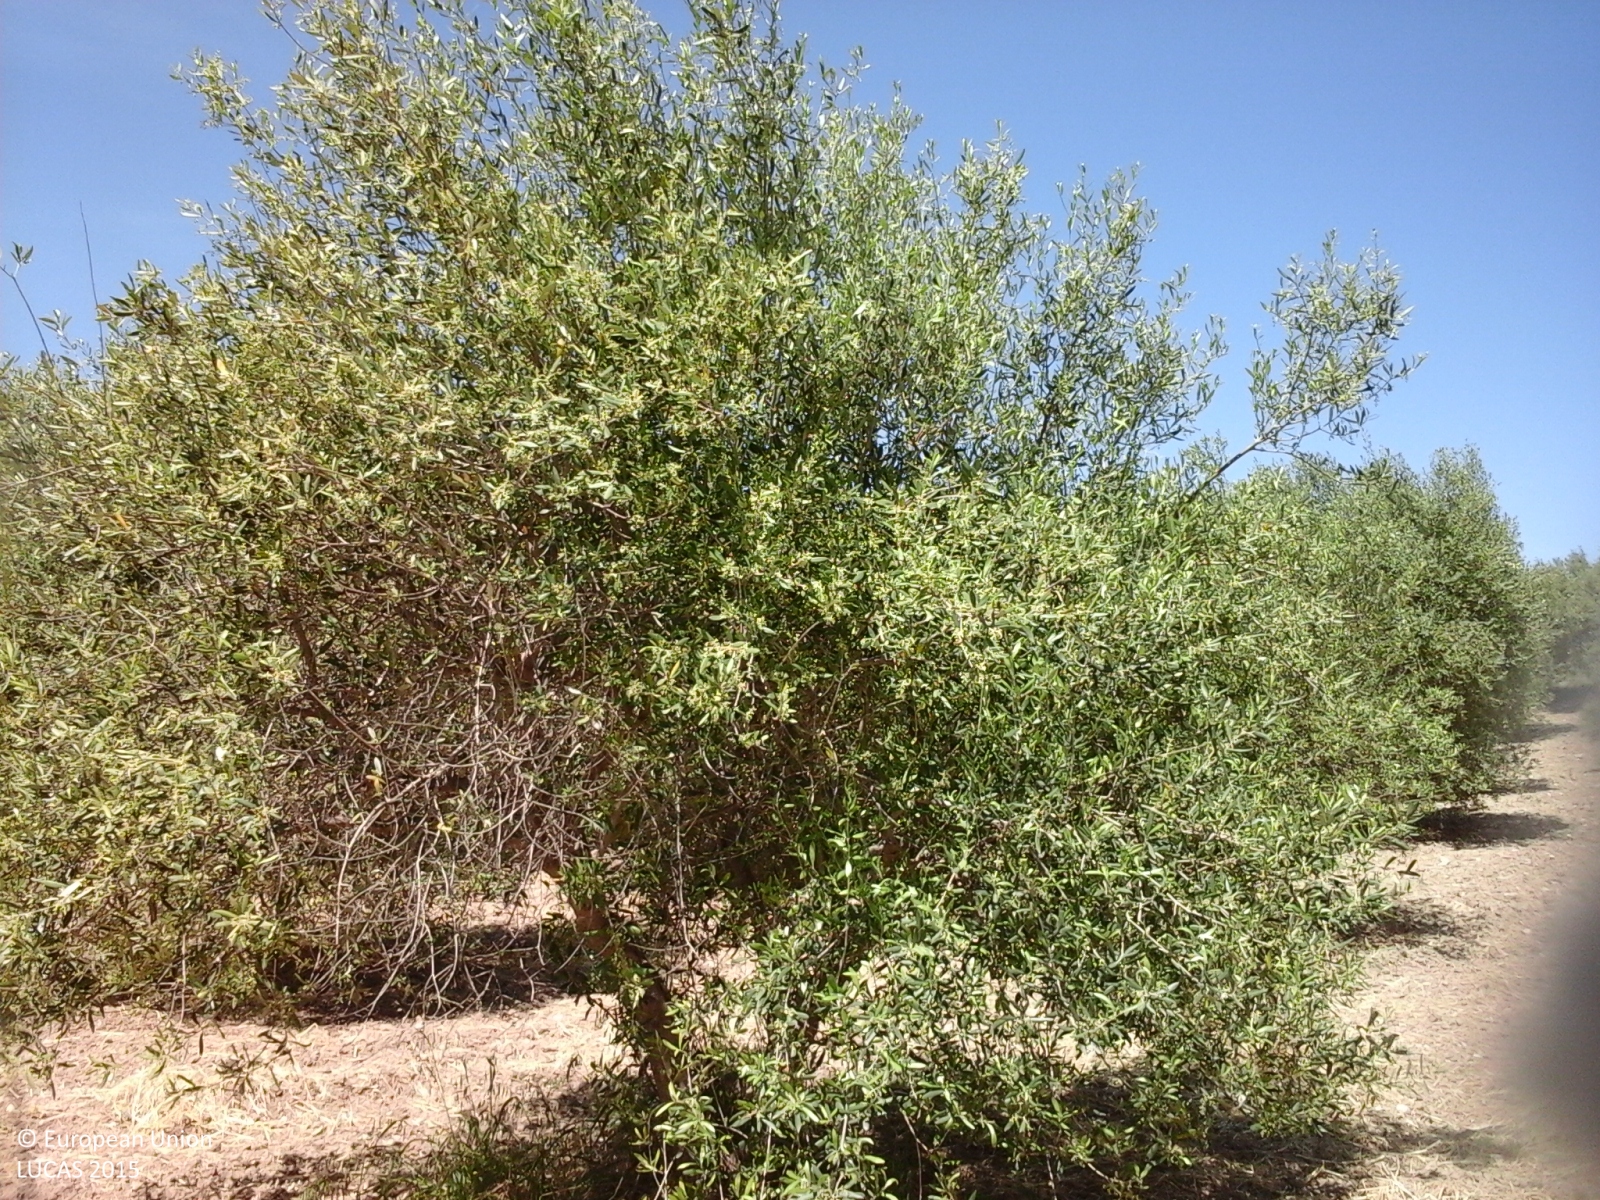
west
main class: Cropland
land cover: Olive groves
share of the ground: > 75 %
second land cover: Other bare soil
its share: > 75 %
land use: Agriculture (excluding fallow land and kitchen gardens)
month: May
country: IT
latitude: 37.4641
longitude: 13.9837
